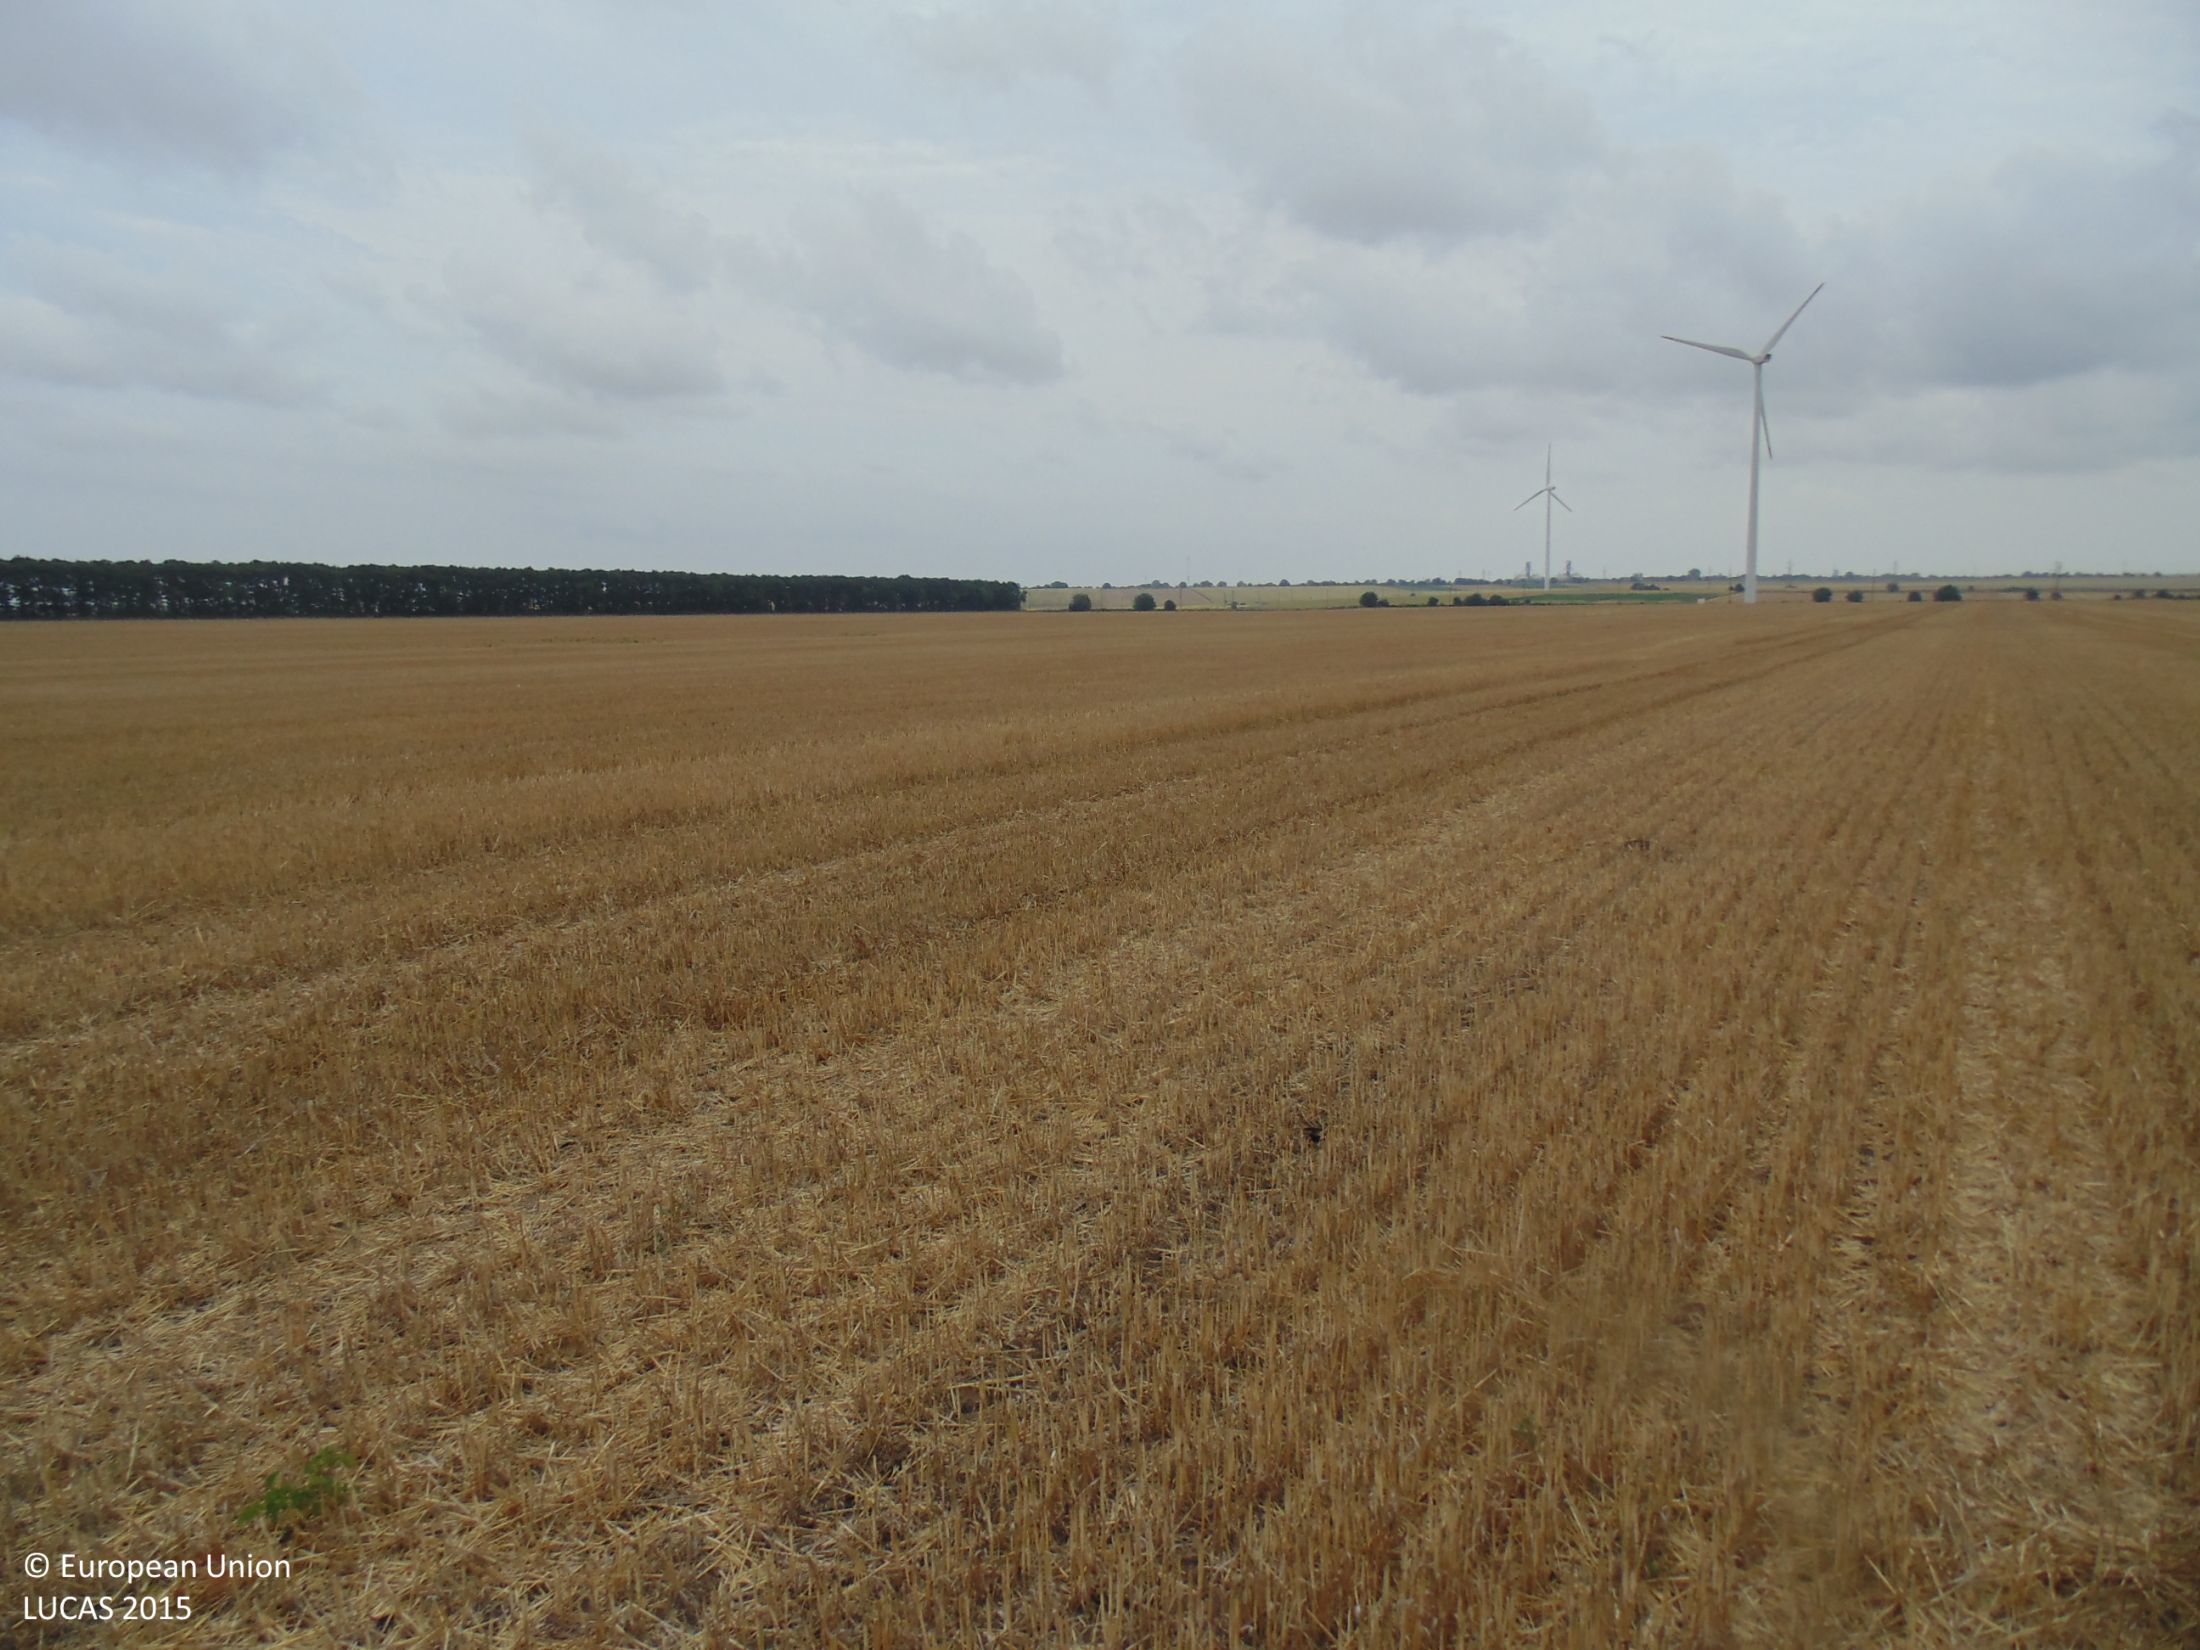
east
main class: Cropland
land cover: Common wheat
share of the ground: 25 - 50 %
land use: Agriculture (excluding fallow land and kitchen gardens)
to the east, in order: Common wheat
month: August
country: BG
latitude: 43.5565
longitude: 28.4949
